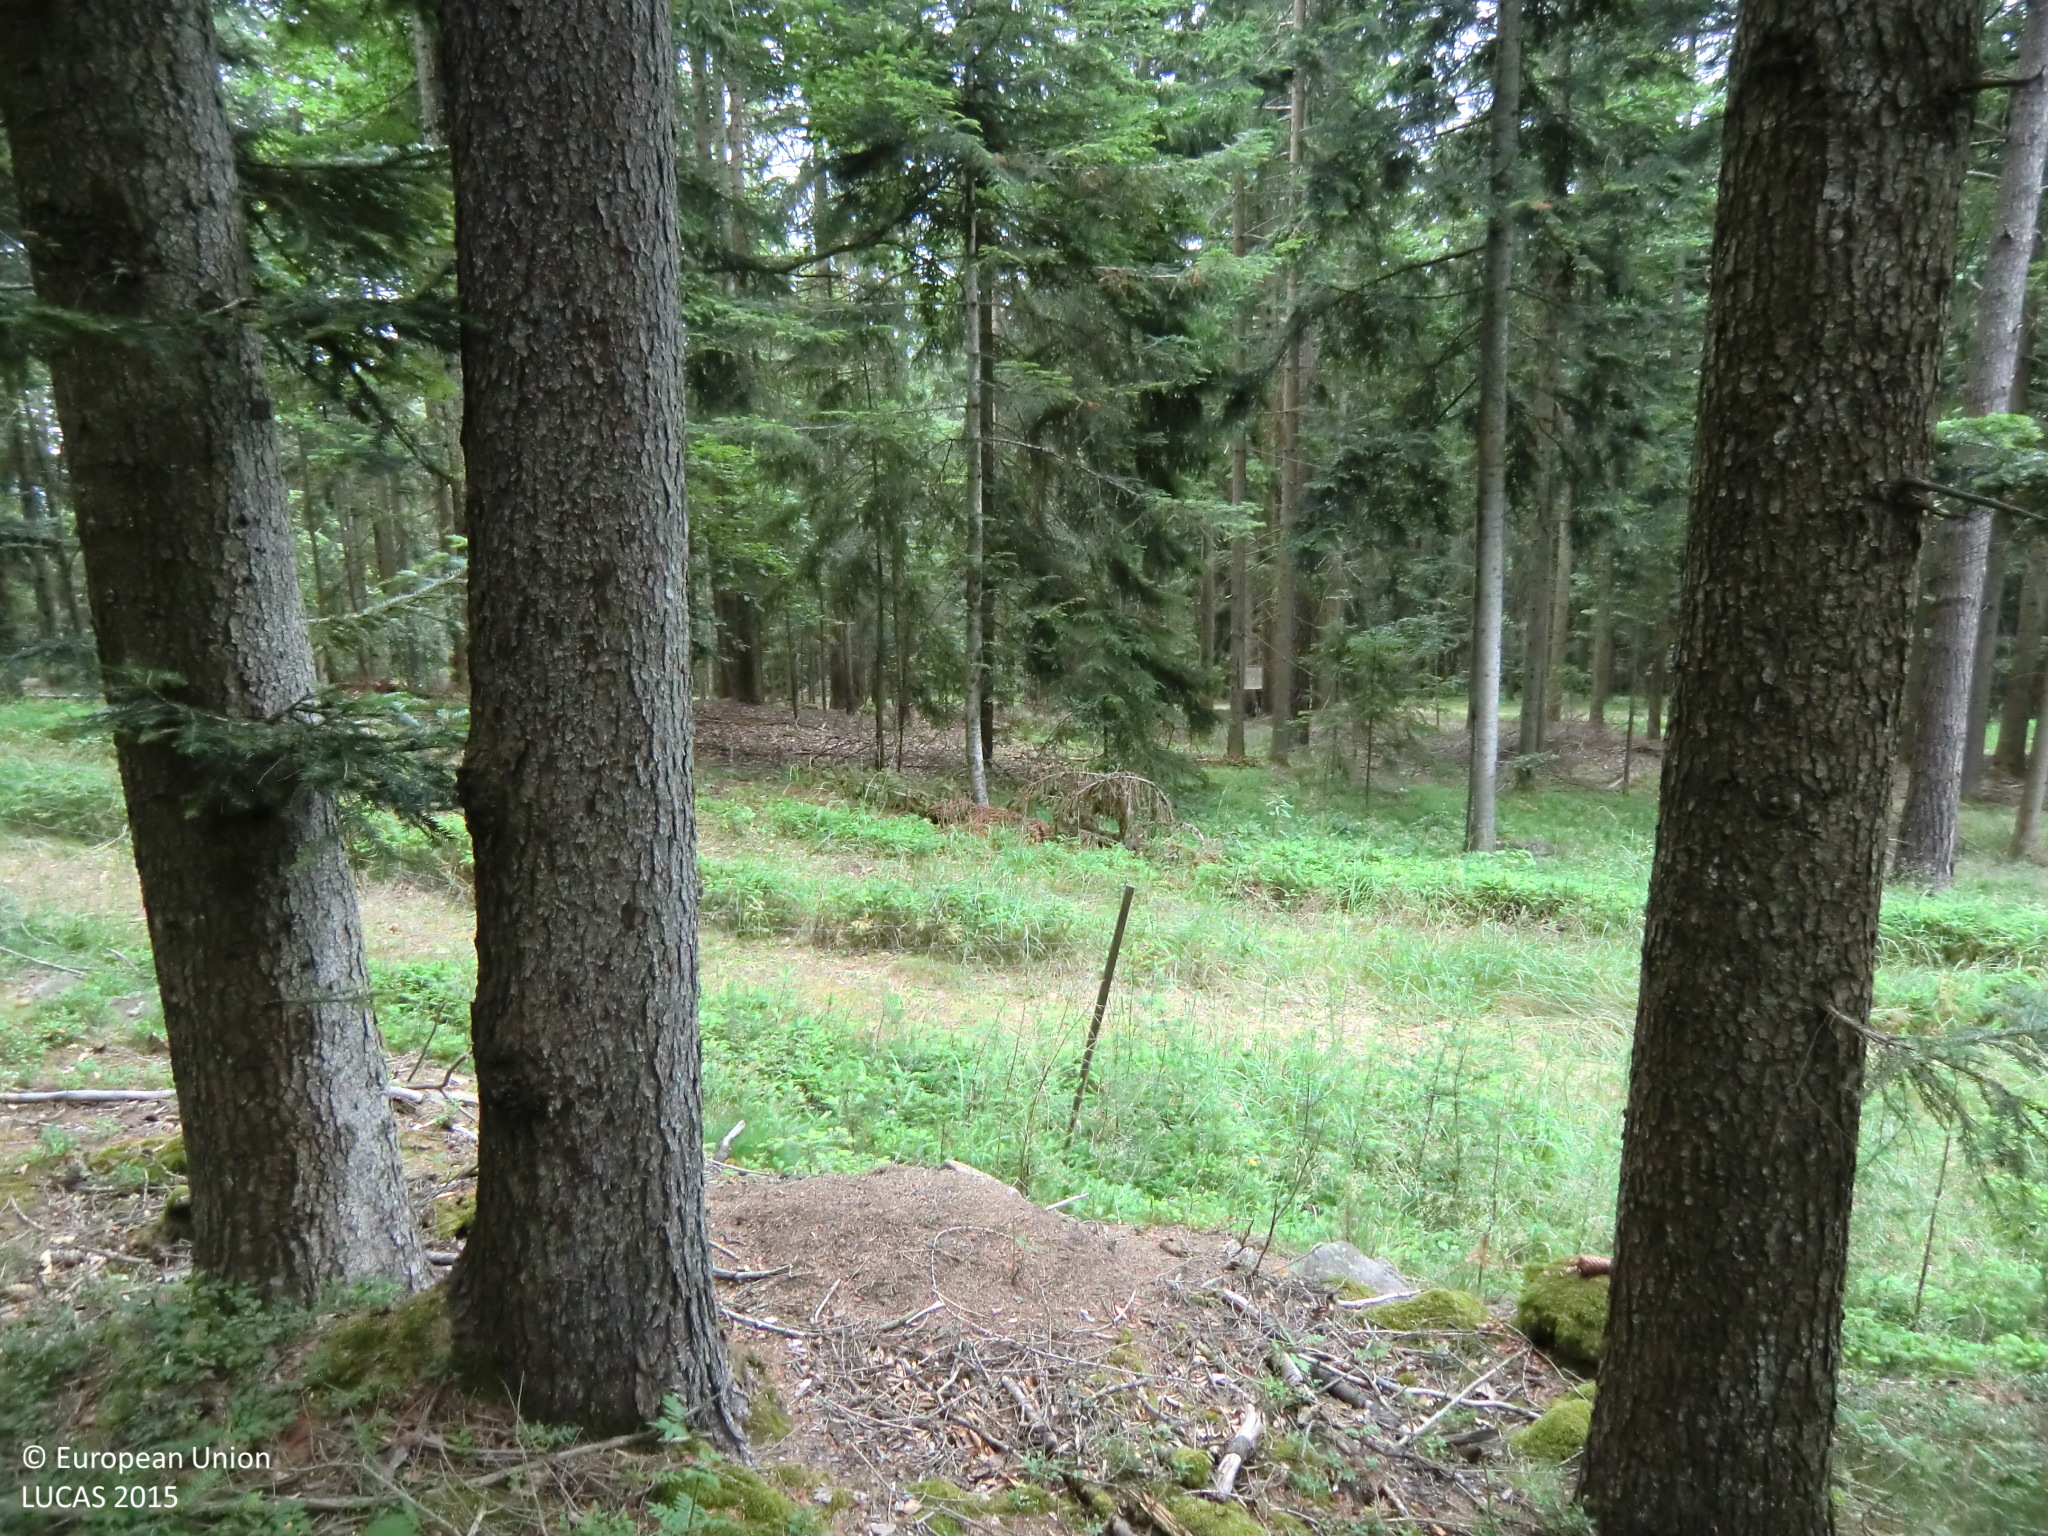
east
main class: Woodland
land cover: Spruce dominated coniferous woodland
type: alpine coniferous forest
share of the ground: > 75 %
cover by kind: coniferous forest trees 85 %, shrubs 10 %, lichens and mosses 5 %
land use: Forestry
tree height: > 5 m
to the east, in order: Spruce dominated coniferous woodland; Fences; Tracks; Spruce dominated coniferous woodland; Tracks; Spruce dominated coniferous woodland; Tracks; Spruce dominated coniferous woodland; Grassland without tree/shrub cover
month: June
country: AT
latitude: 47.2781
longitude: 15.7781
